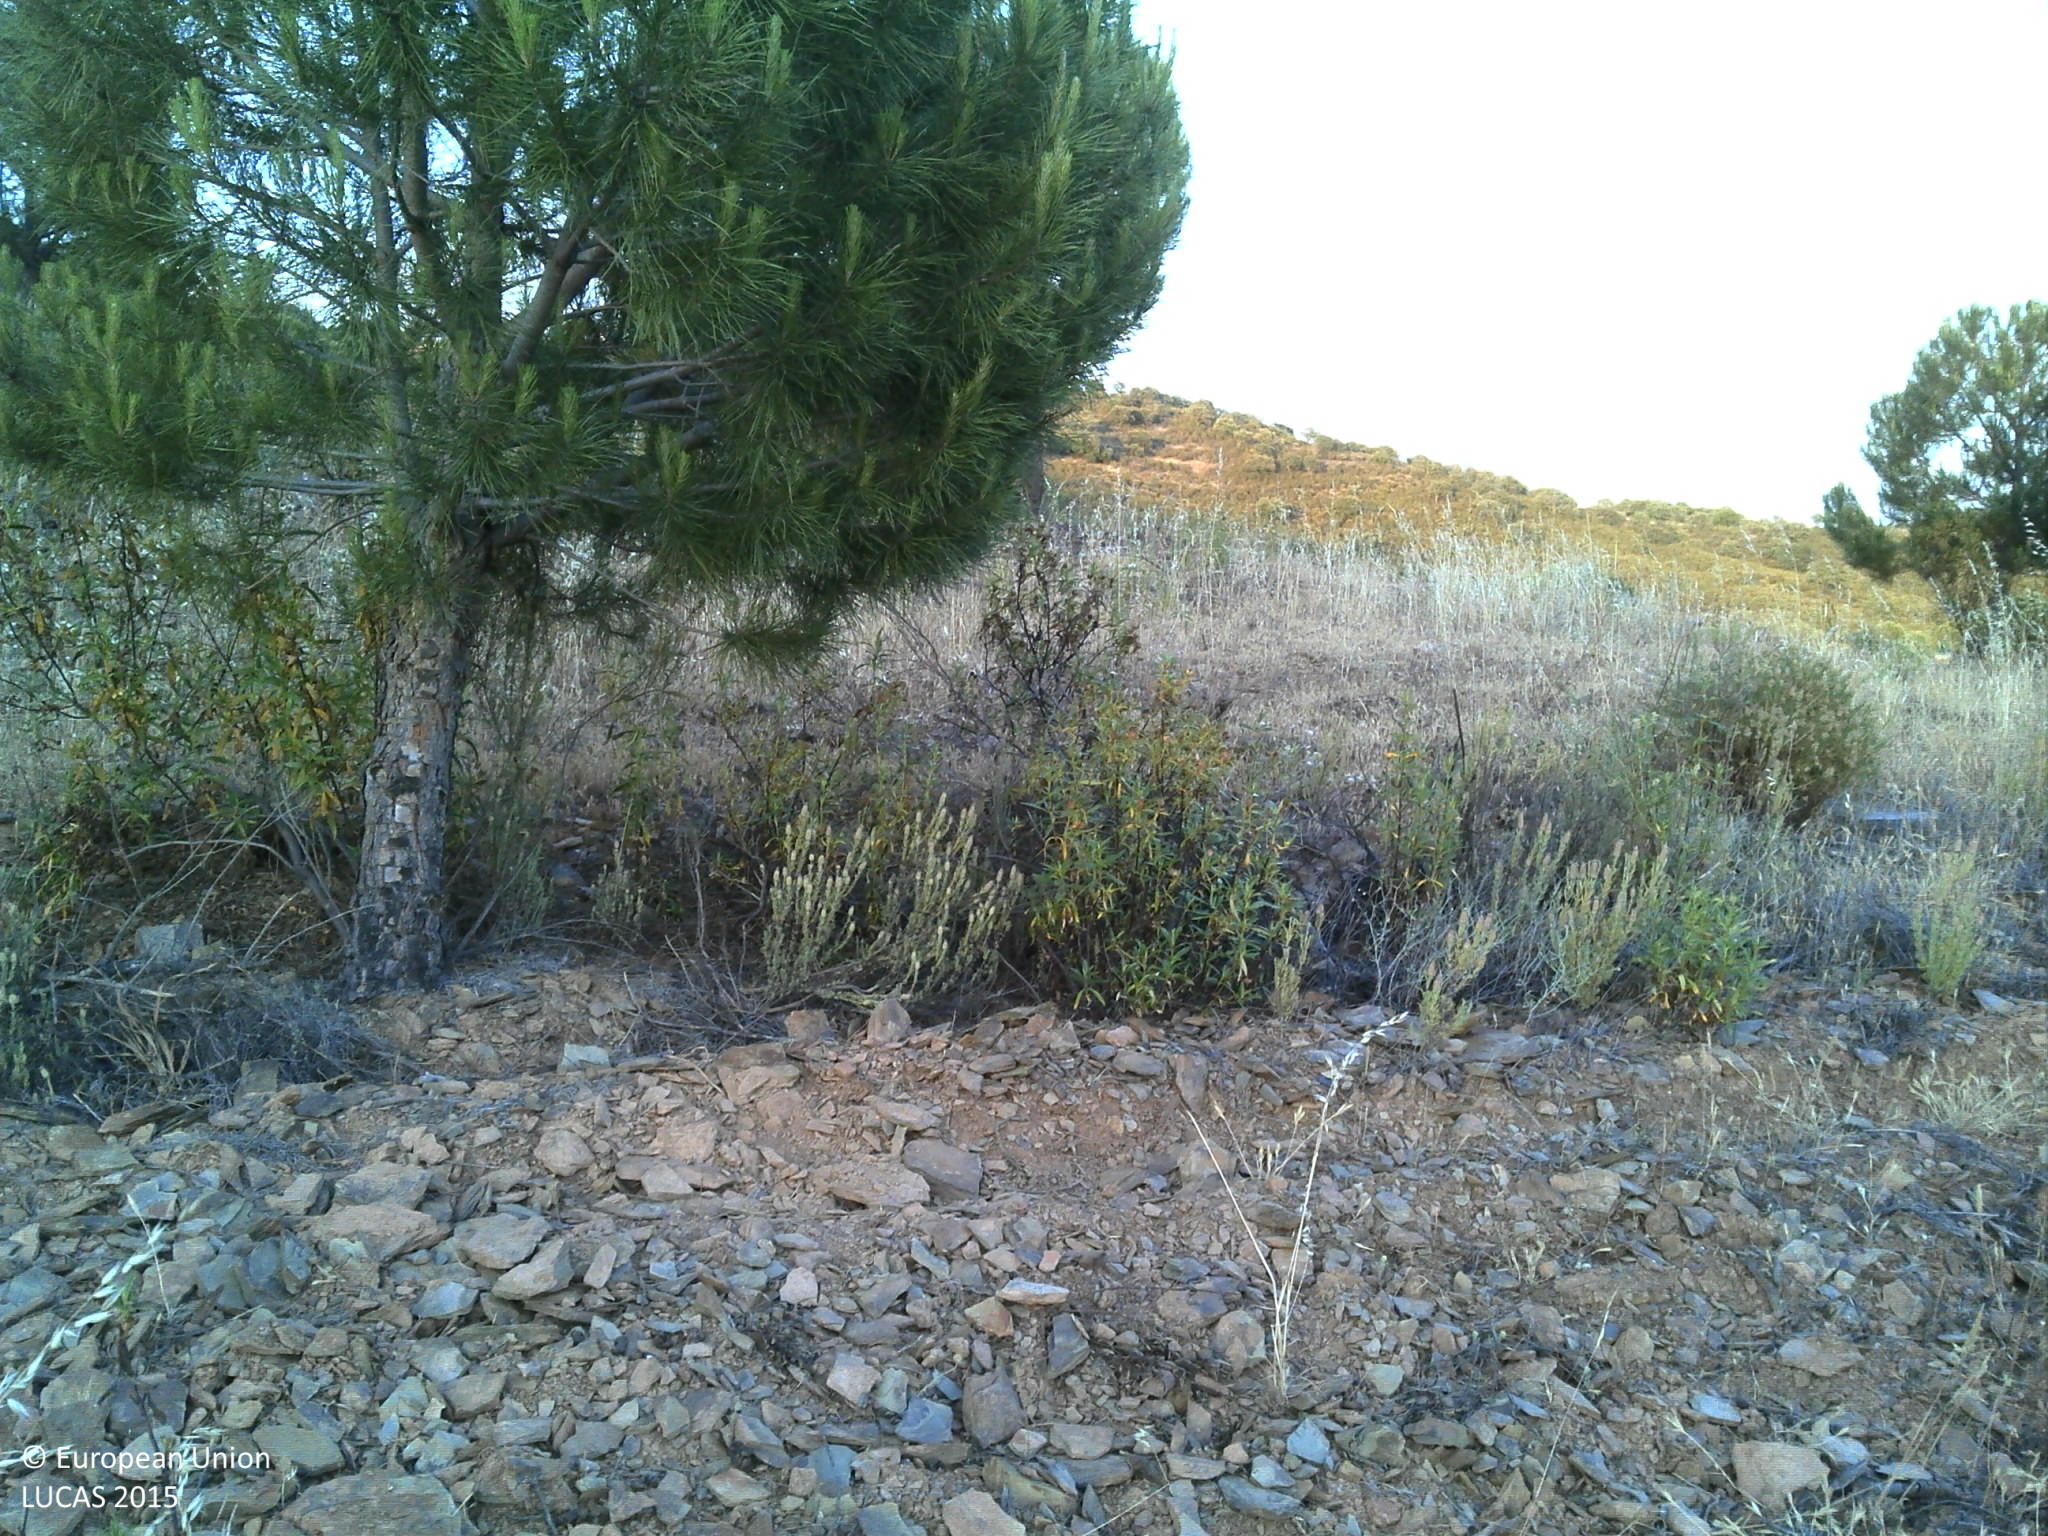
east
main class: Woodland
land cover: Pine dominated coniferous woodland
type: coniferous forest of the mediterranean region
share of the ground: 10 - 25 %
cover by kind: herbaceous plants 60 %, coniferous forest trees 25 %, consolidated bare surface 10 %, shrubs 5 %
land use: Forestry
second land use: Agriculture (excluding fallow land and kitchen gardens)
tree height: < 5 m
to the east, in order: Pine dominated coniferous woodland; Tracks; Pine dominated coniferous woodland; Shrubland with sparse tree cover; Ditches and canals; Dry stone walls; Olive groves; Shrubland without tree cover
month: May
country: PT
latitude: 37.4863
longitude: -7.7592
